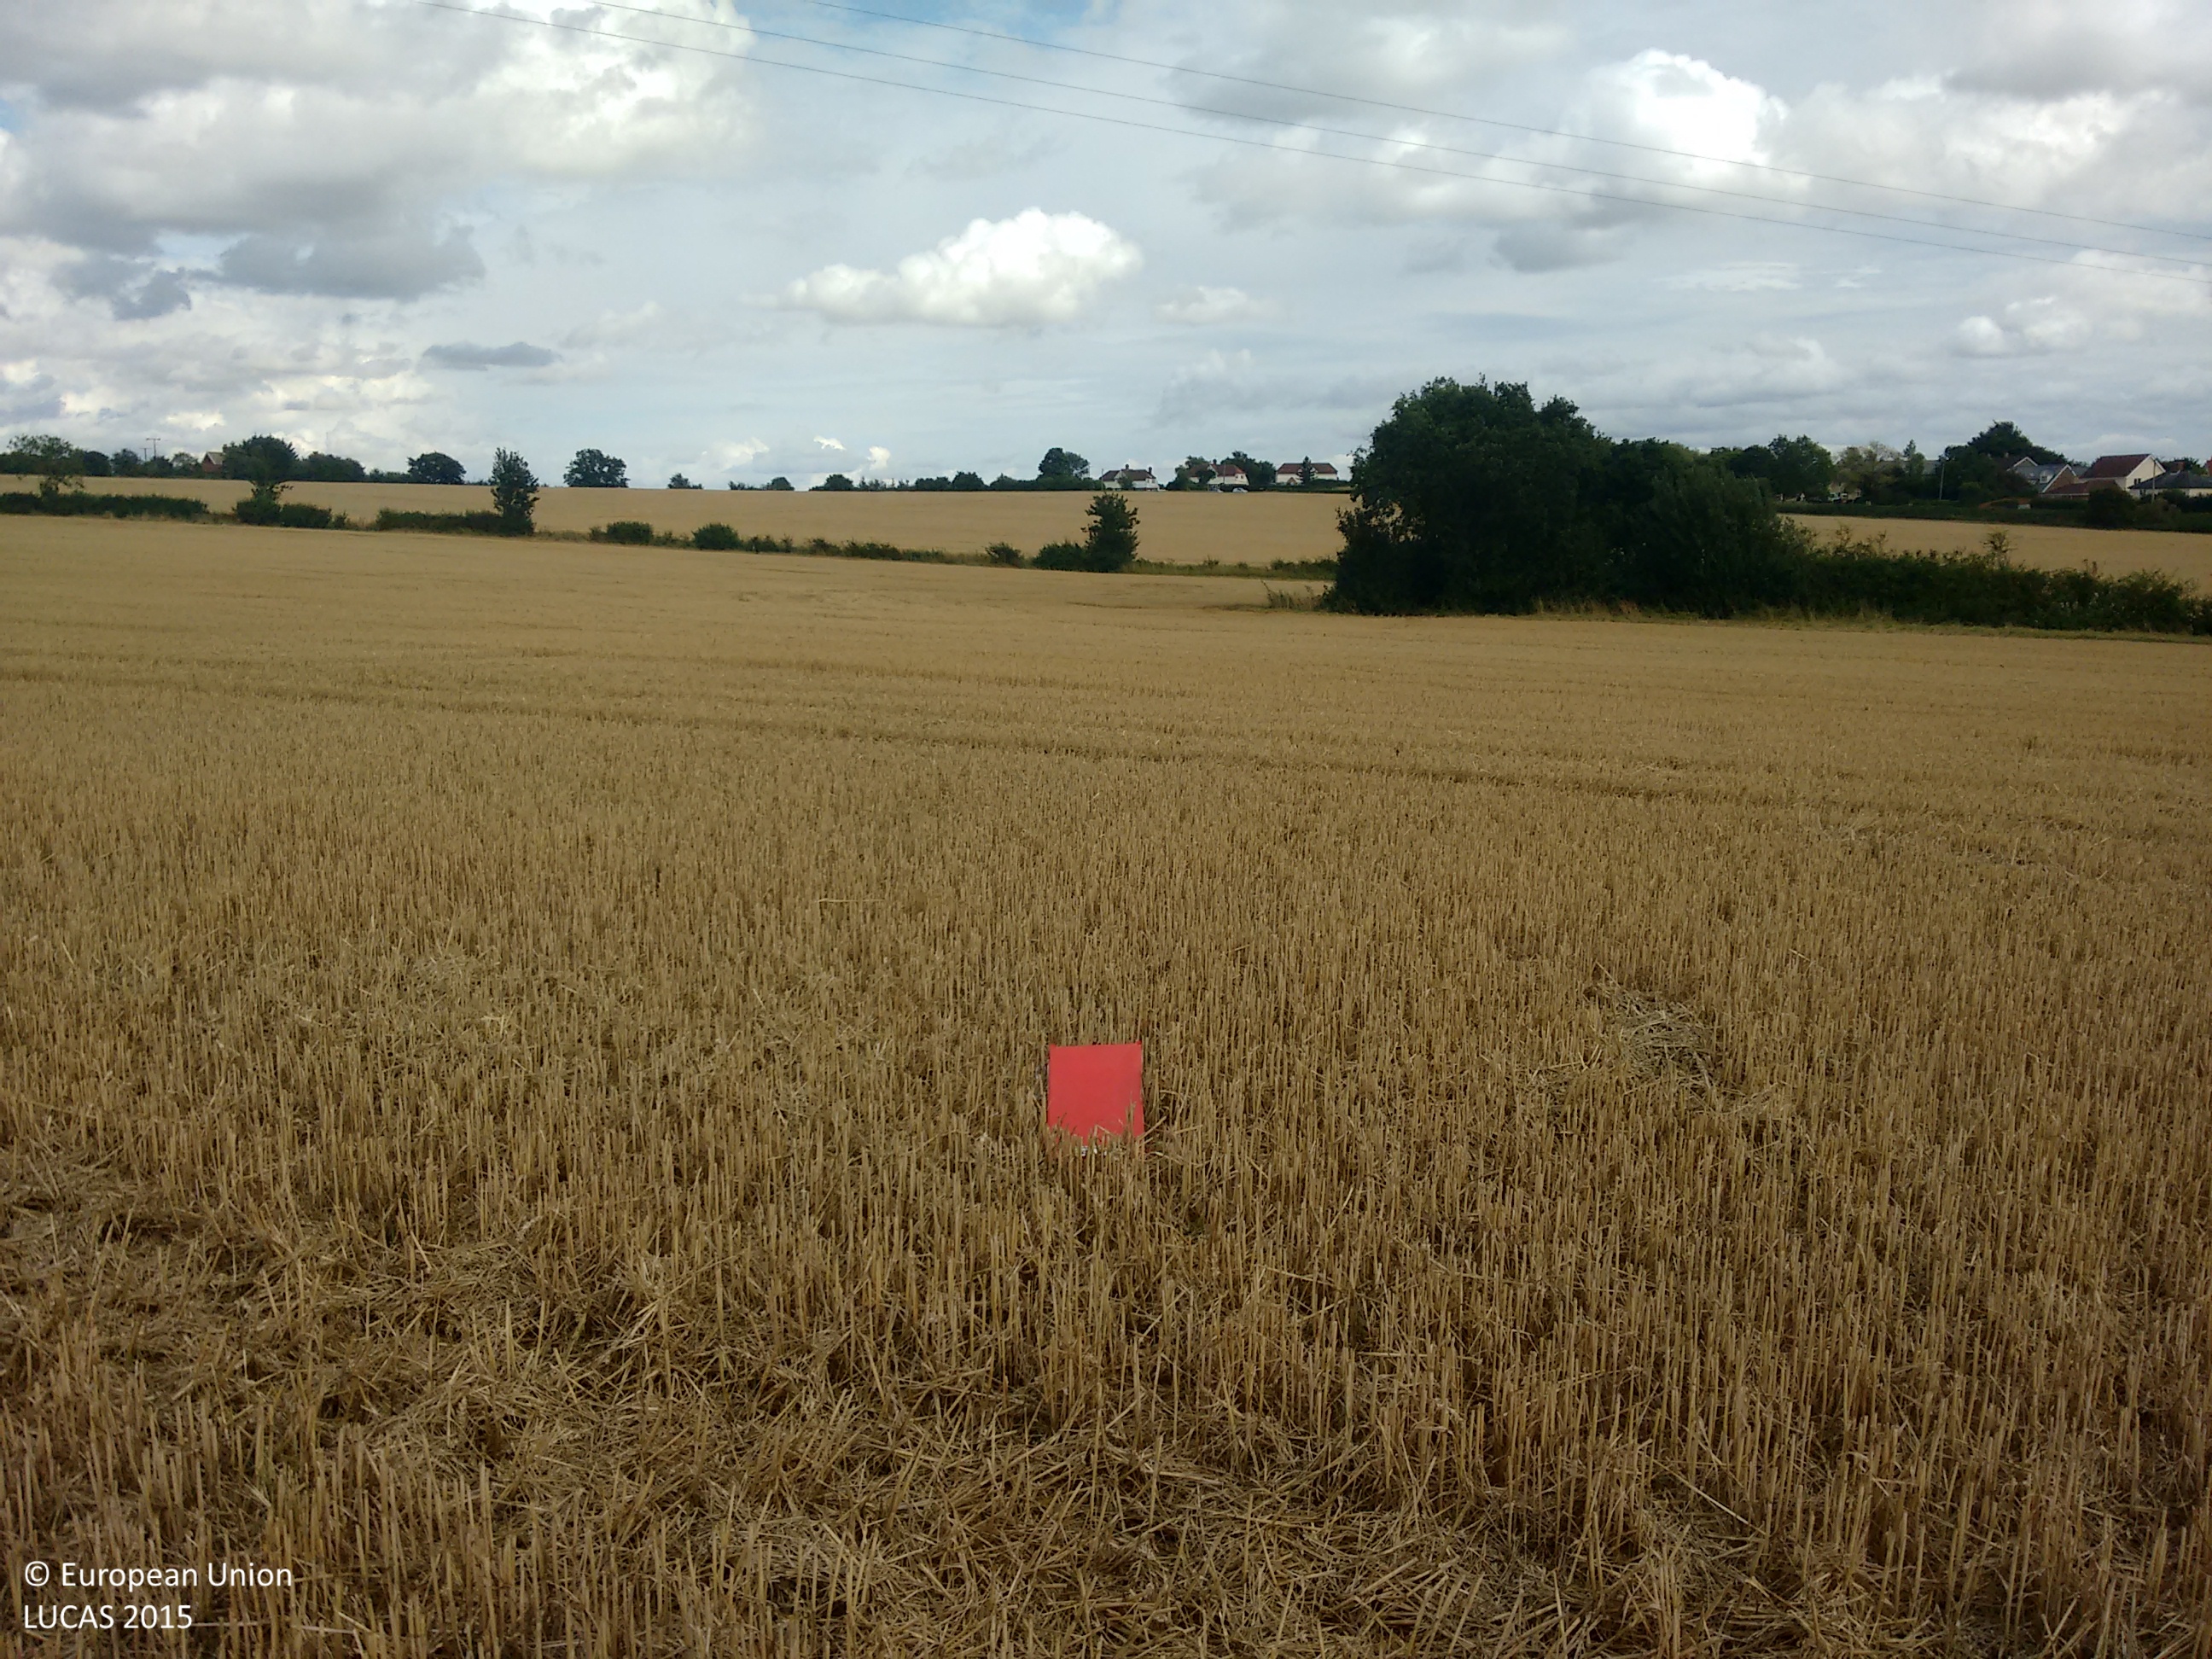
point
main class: Cropland
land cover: Common wheat
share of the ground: > 75 %
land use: Agriculture (excluding fallow land and kitchen gardens)
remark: Harvested field
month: August
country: GB
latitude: 52.1645
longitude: 0.5726
